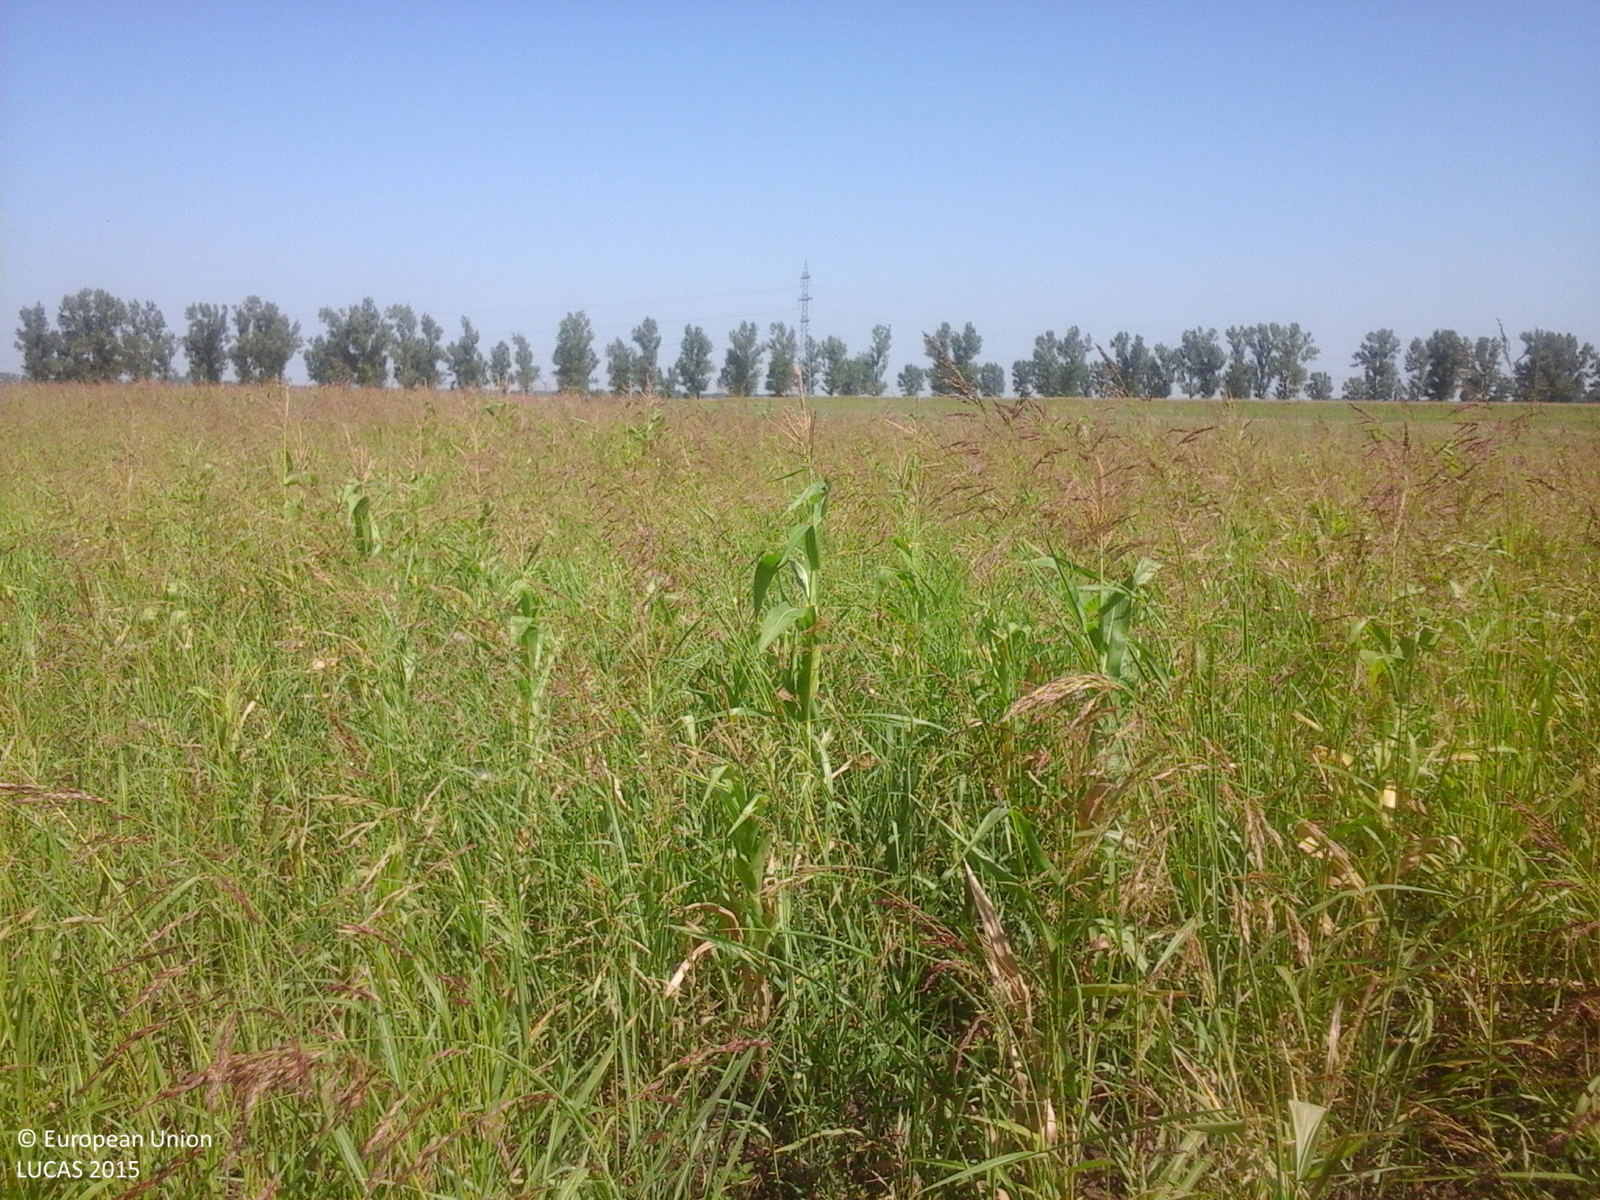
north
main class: Grassland
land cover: Spontaneously vegetated surfaces
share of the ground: 50 - 75 %
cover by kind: herbaceous plants 100 %
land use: Fallow land
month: July
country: RO
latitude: 44.2331
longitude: 26.6044
